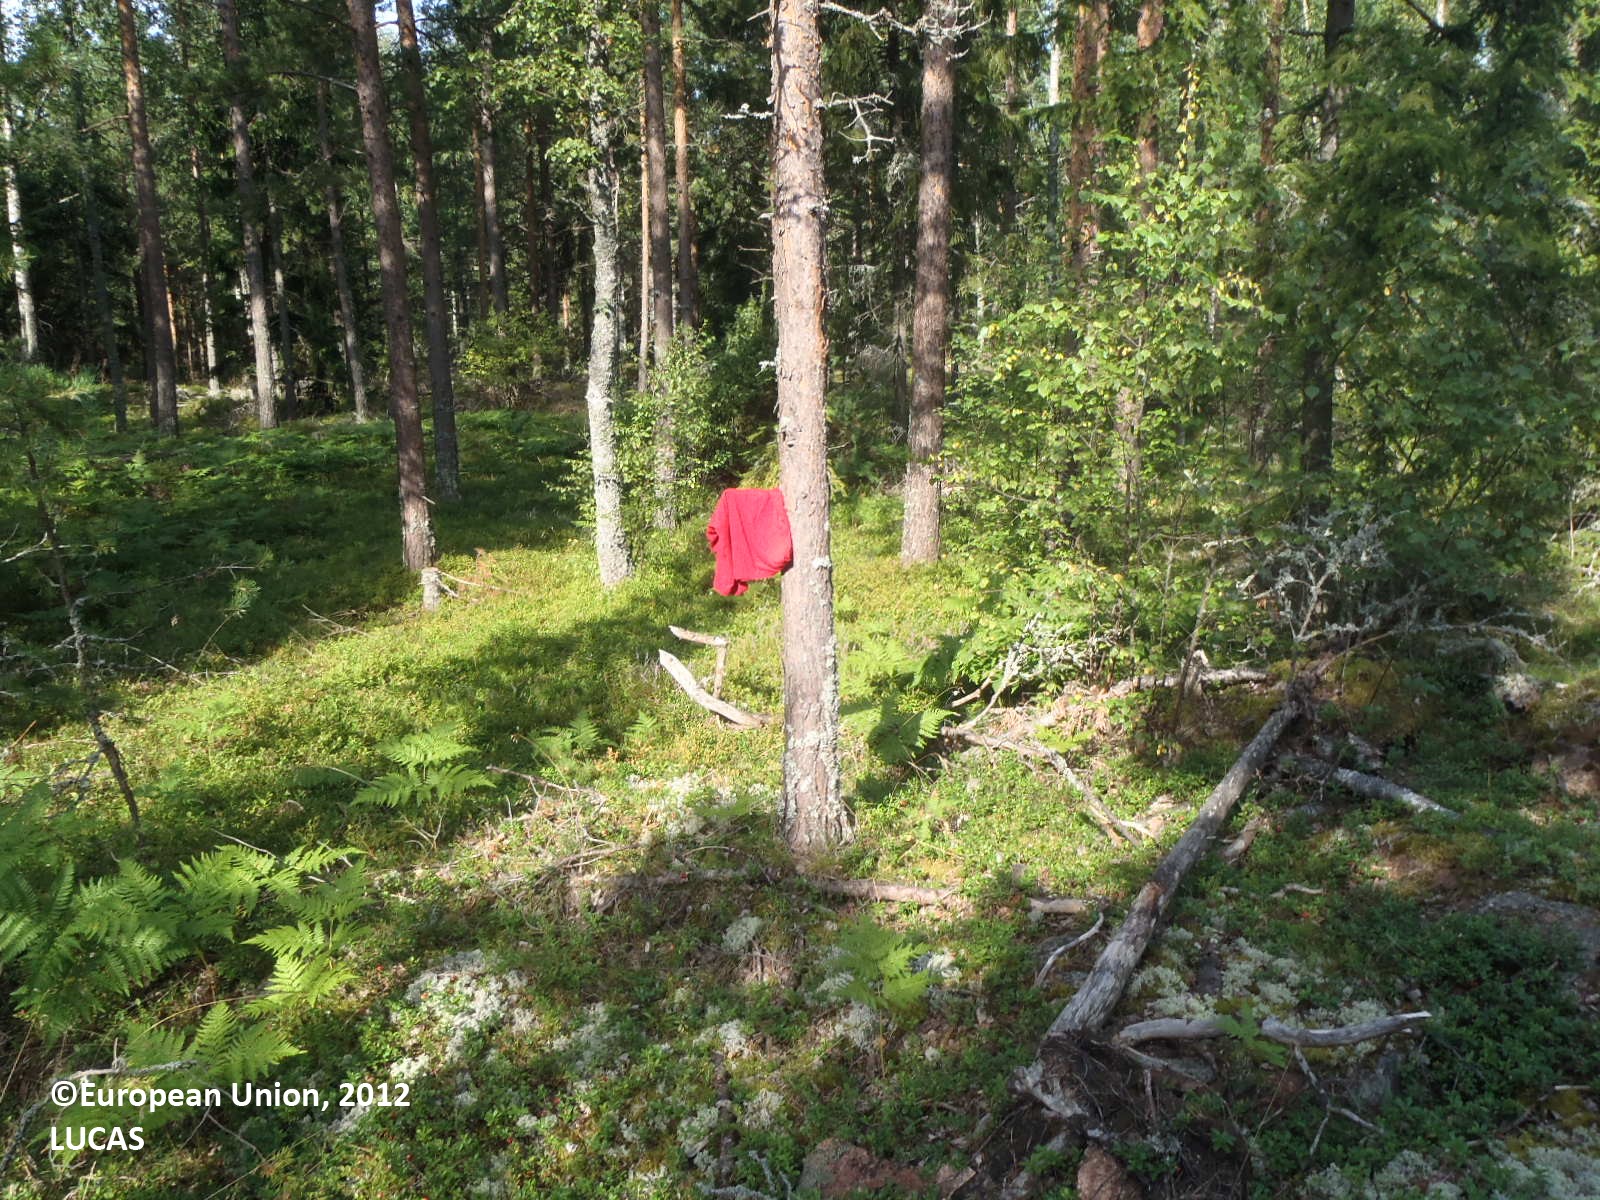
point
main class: Woodland
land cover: Pine dominated mixed woodland
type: hemiboreal forest and nemoral coniferous forest and mixed broadleaved-coniferous forest
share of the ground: 50 - 75 %
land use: Forestry
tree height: > 5 m
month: August
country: FI
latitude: 60.1867
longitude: 20.2694
